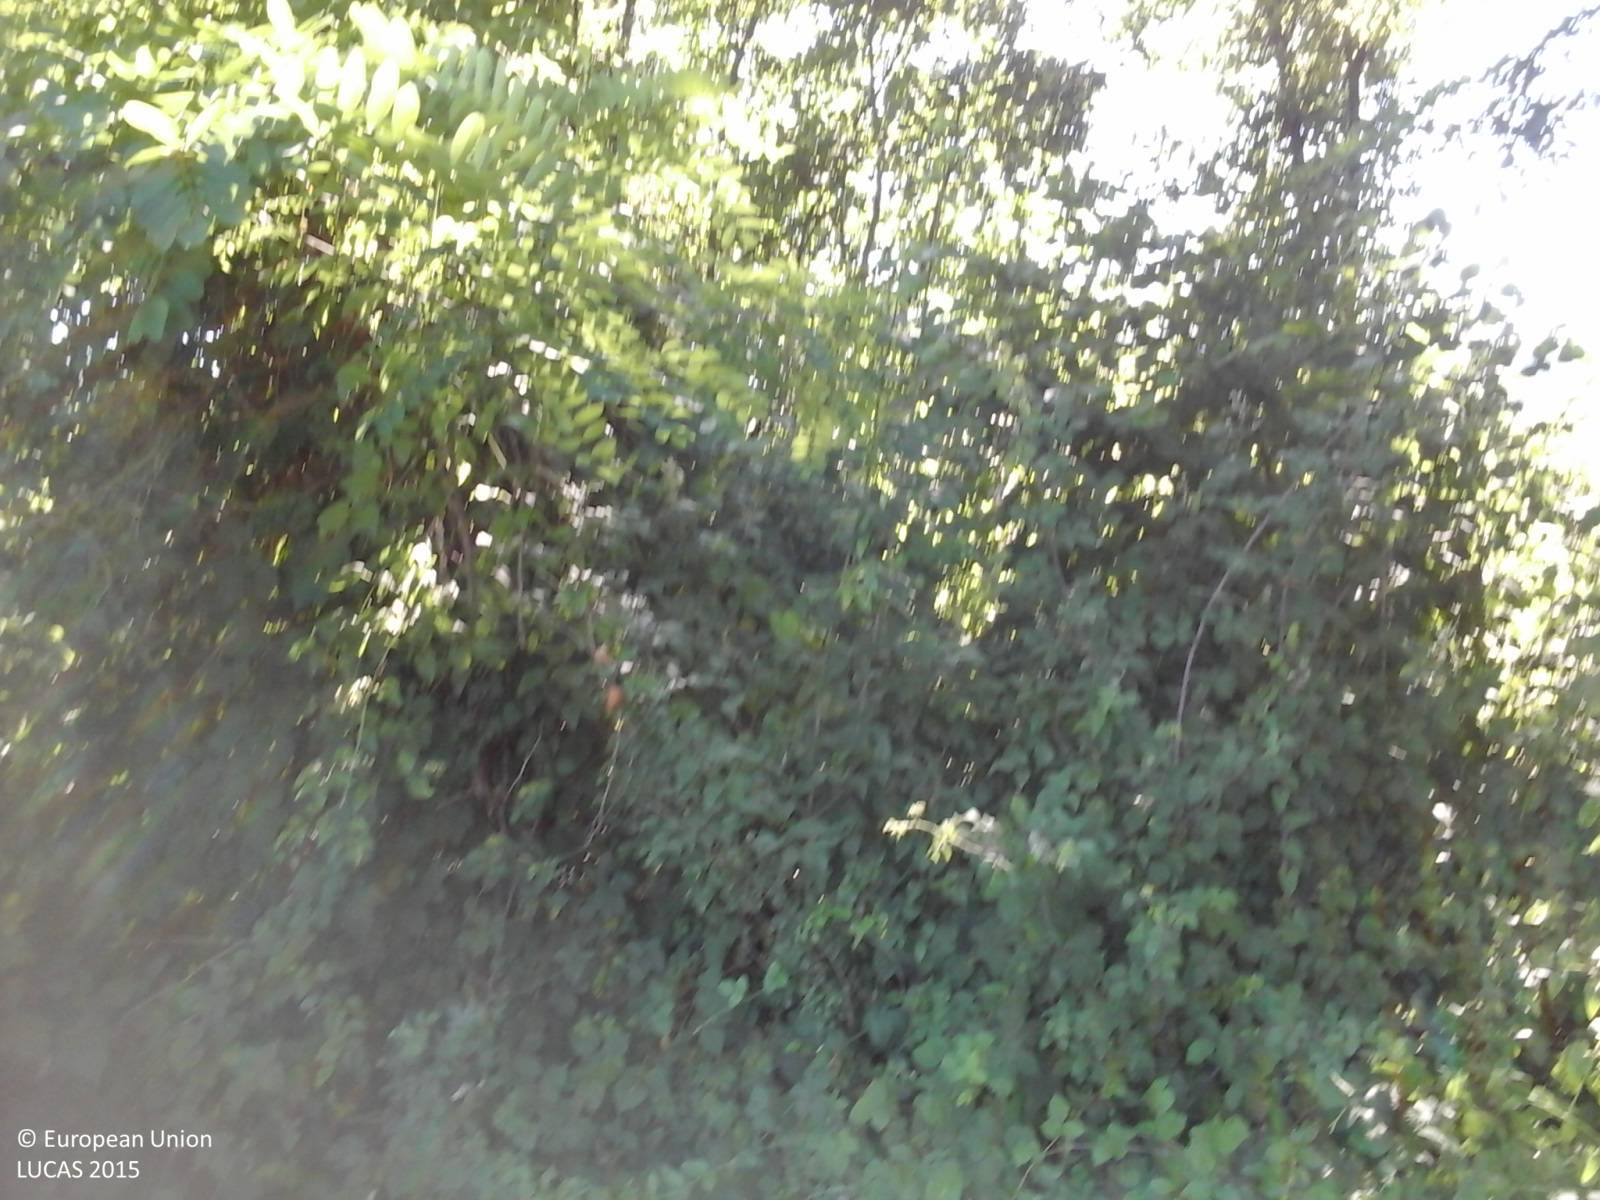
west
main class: Shrubland
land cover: Shrubland with sparse tree cover
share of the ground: > 75 %
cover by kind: shrubs 55 %, unconsolidated bare surface 40 %, broadleaved forest trees 5 %
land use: Semi-natural and natural areas not in use
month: June
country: IT
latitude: 44.3325
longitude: 9.9124
